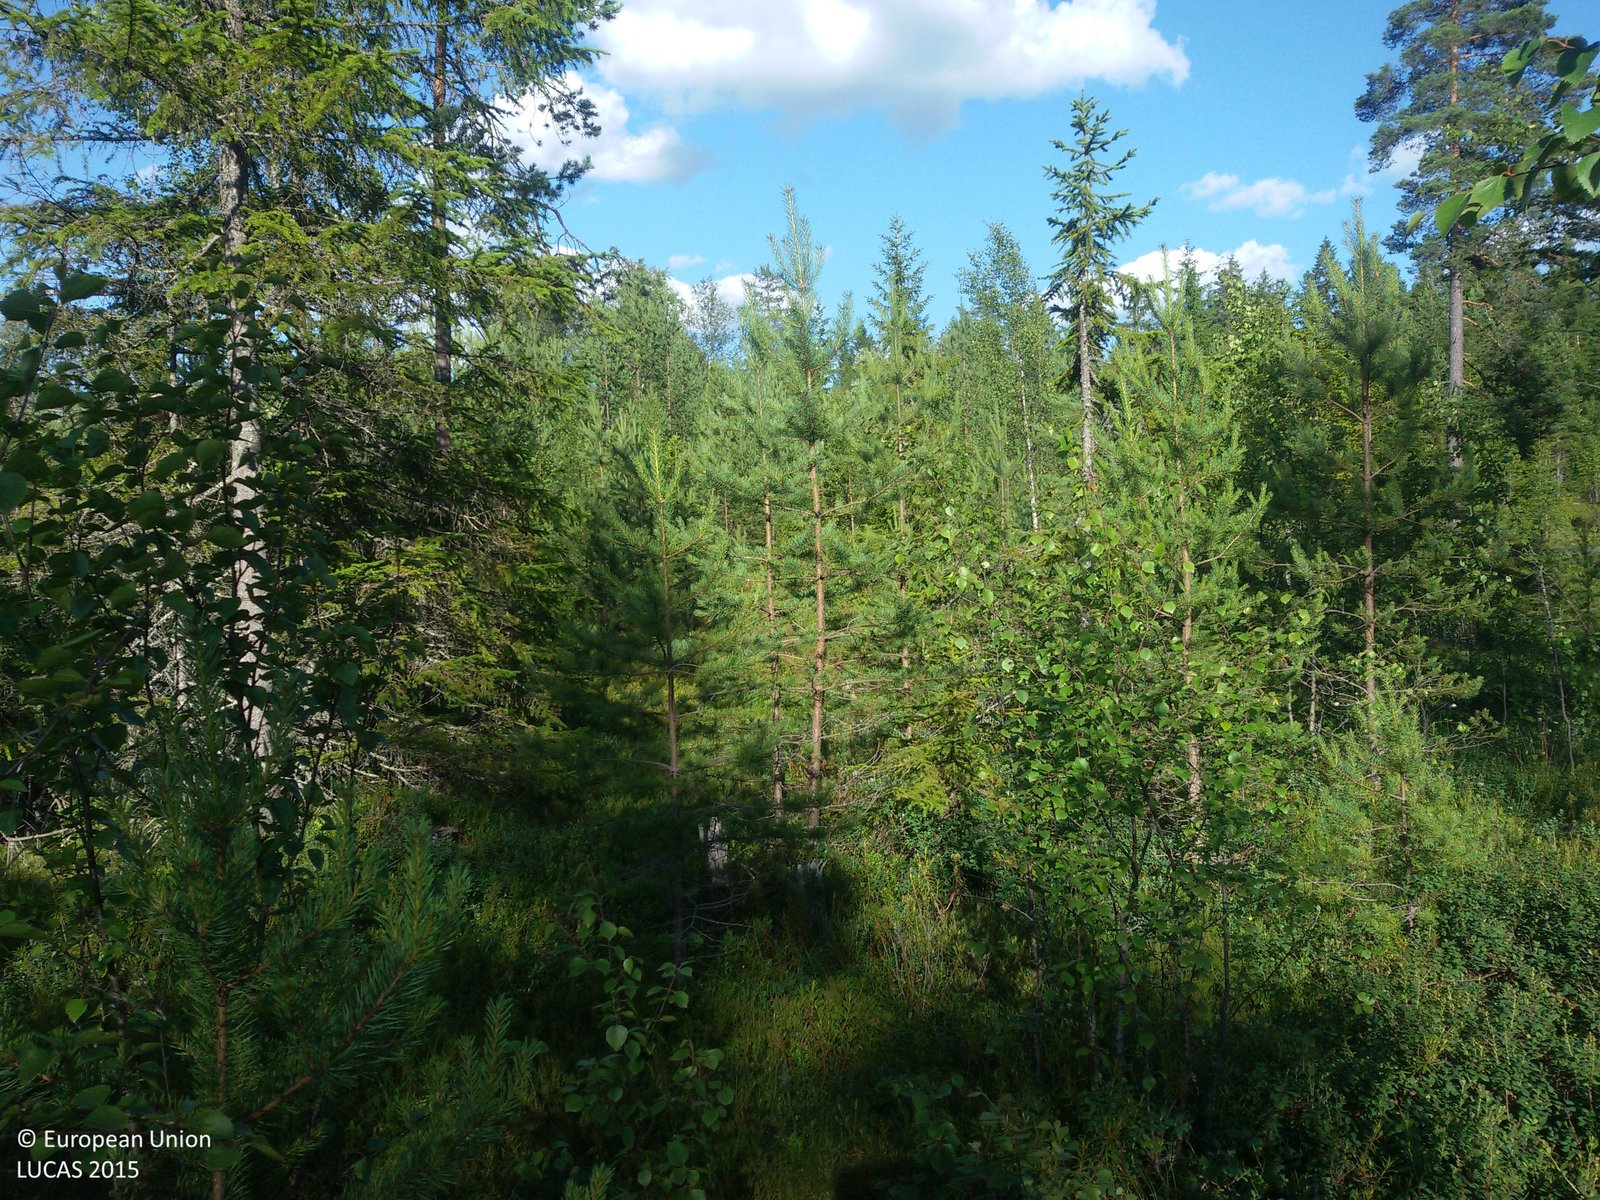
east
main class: Woodland
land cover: Pine dominated coniferous woodland
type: boreal forest
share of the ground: 50 - 75 %
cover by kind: coniferous forest trees 50 %, herbaceous plants 50 %
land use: Forestry
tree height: > 5 m
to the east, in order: Pine dominated coniferous woodland; Spruce dominated coniferous woodland; Spruce dominated mixed woodland; Electric lines; Spruce dominated mixed woodland
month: July
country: SE
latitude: 60.6762
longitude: 15.3138
